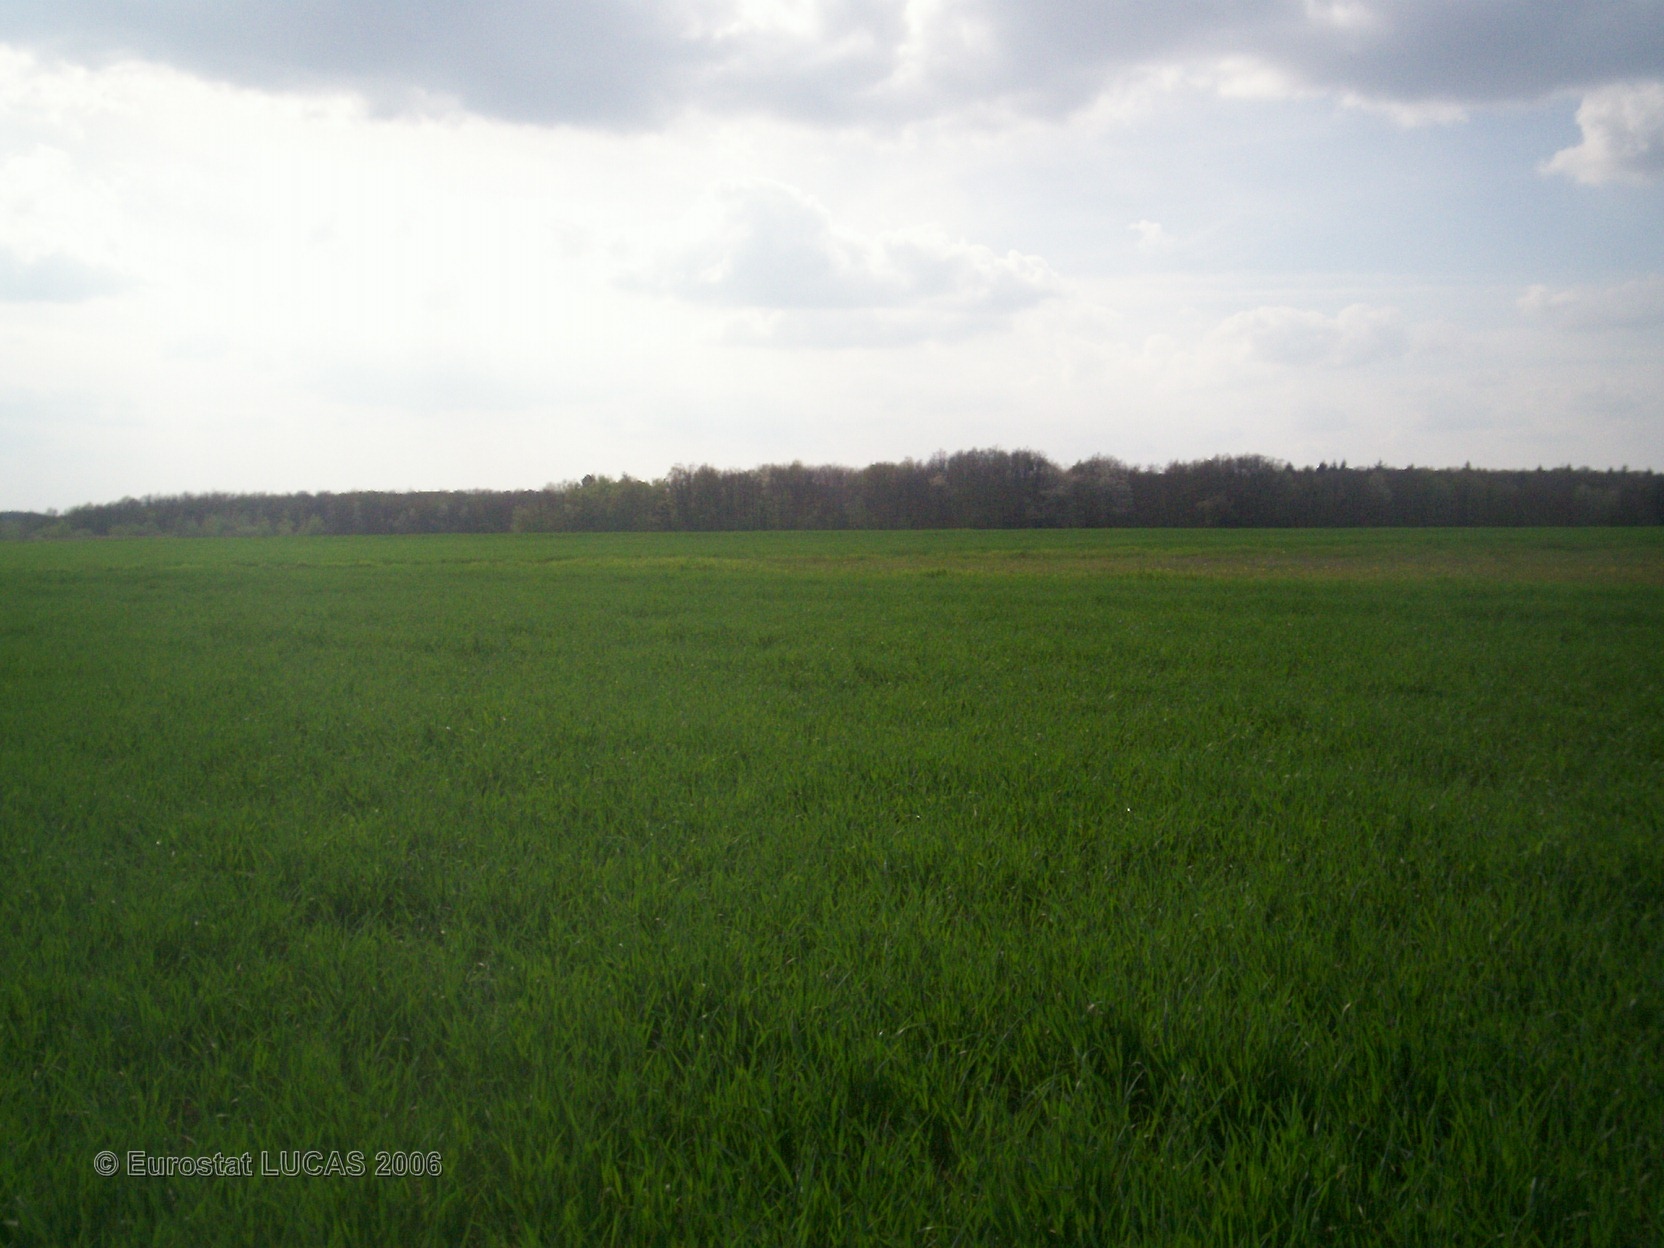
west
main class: Cropland
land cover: Common wheat
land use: Agriculture (excluding fallow land and kitchen gardens)
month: April
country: FR
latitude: 47.7891
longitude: 0.8635
